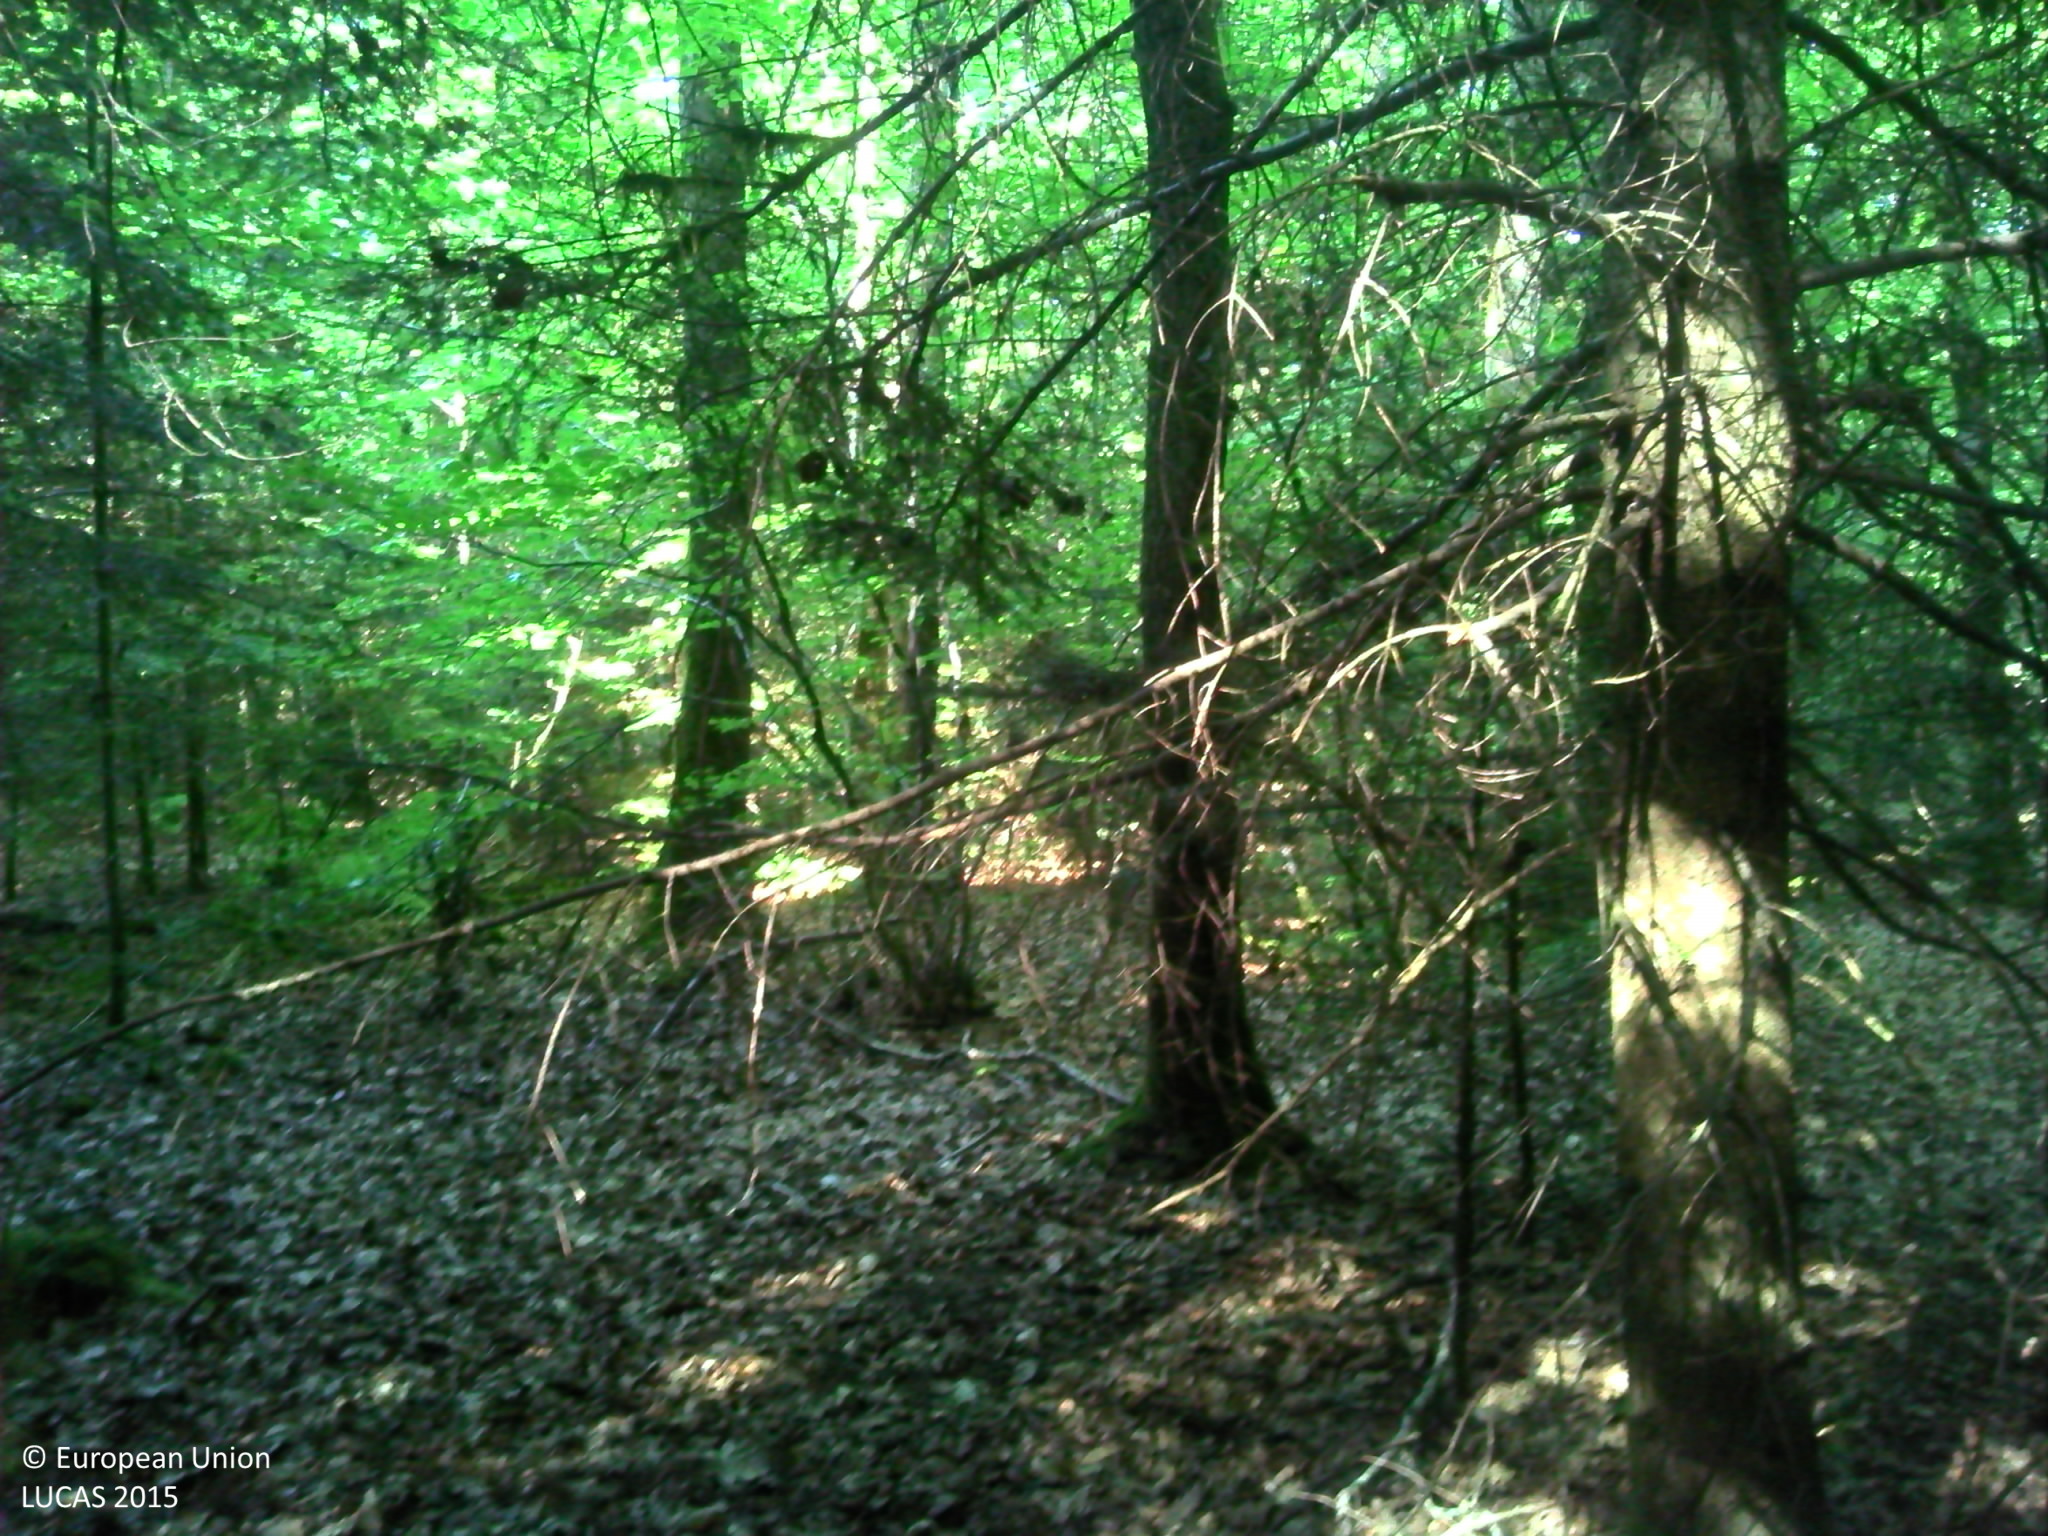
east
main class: Woodland
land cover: Spruce dominated mixed woodland
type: mesophytic deciduous forest
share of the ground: > 75 %
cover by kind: coniferous forest trees 40 %, broadleaved forest trees 30 %, herbaceous plants 15 %, consolidated bare surface 10 %, lichens and mosses 5 %
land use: Forestry
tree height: > 5 m
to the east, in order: Spruce dominated mixed woodland
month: June
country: FR
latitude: 49.1174
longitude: 1.1697
